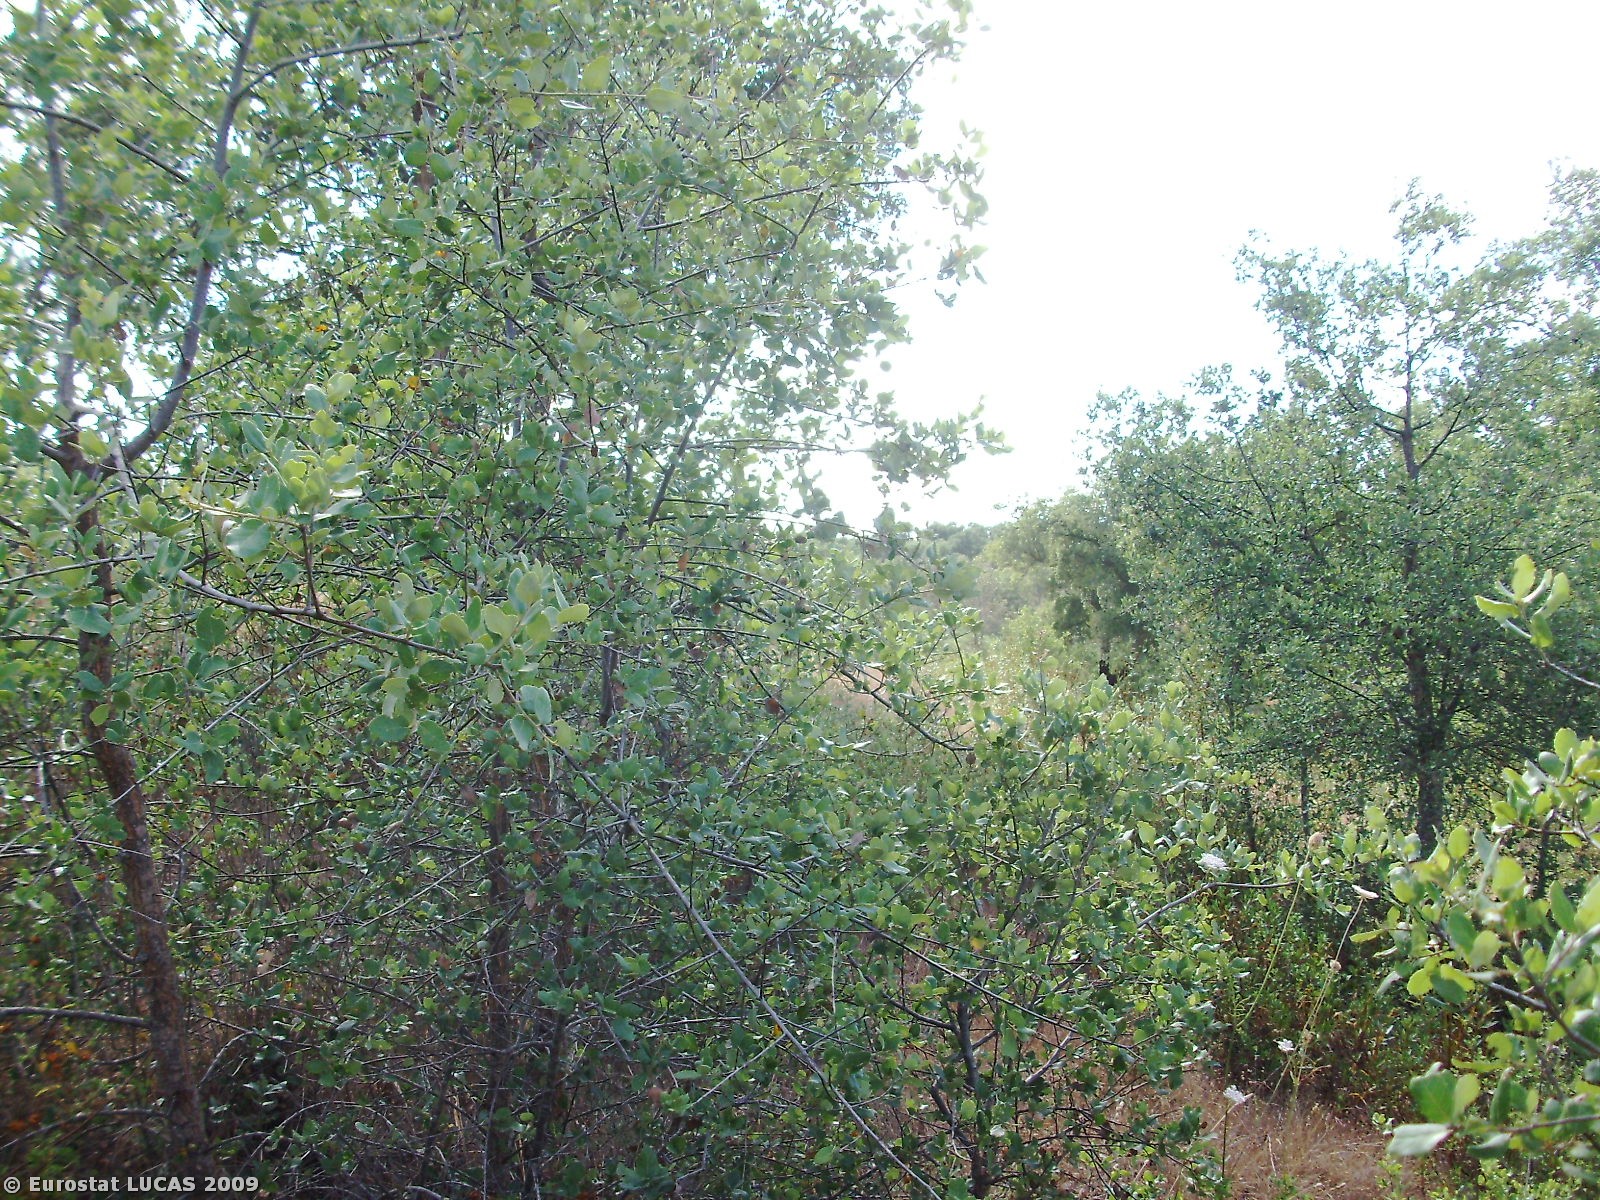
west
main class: Woodland
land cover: Broadleaved woodland
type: broadleaved evergreen forest
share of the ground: 10 - 25 %
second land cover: Shrubland with sparse tree cover
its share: 25 - 50 %
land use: Forestry
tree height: > 5 m
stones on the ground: 25 - 50 %
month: June
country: PT
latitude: 37.8019
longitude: -8.5179
